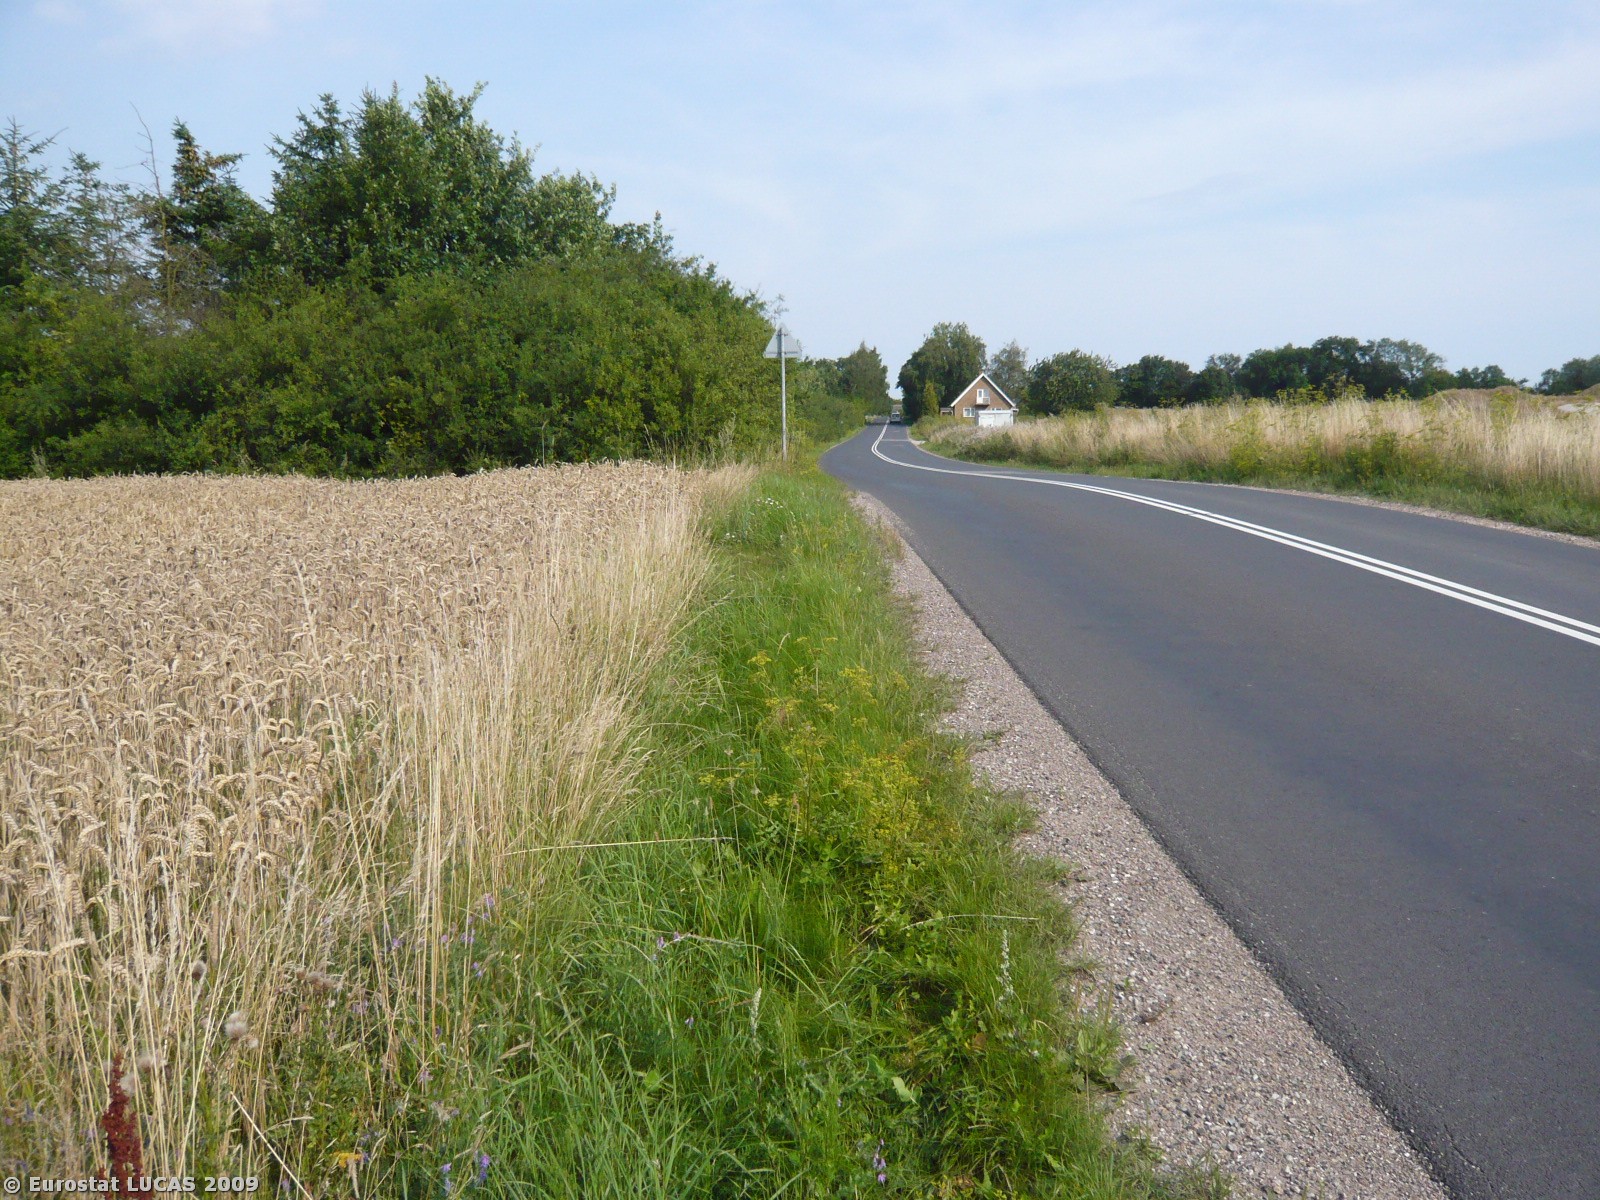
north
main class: Cropland
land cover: Common wheat
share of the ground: > 75 %
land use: Agriculture (excluding fallow land and kitchen gardens)
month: August
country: DK
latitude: 56.0072
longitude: 12.1951
